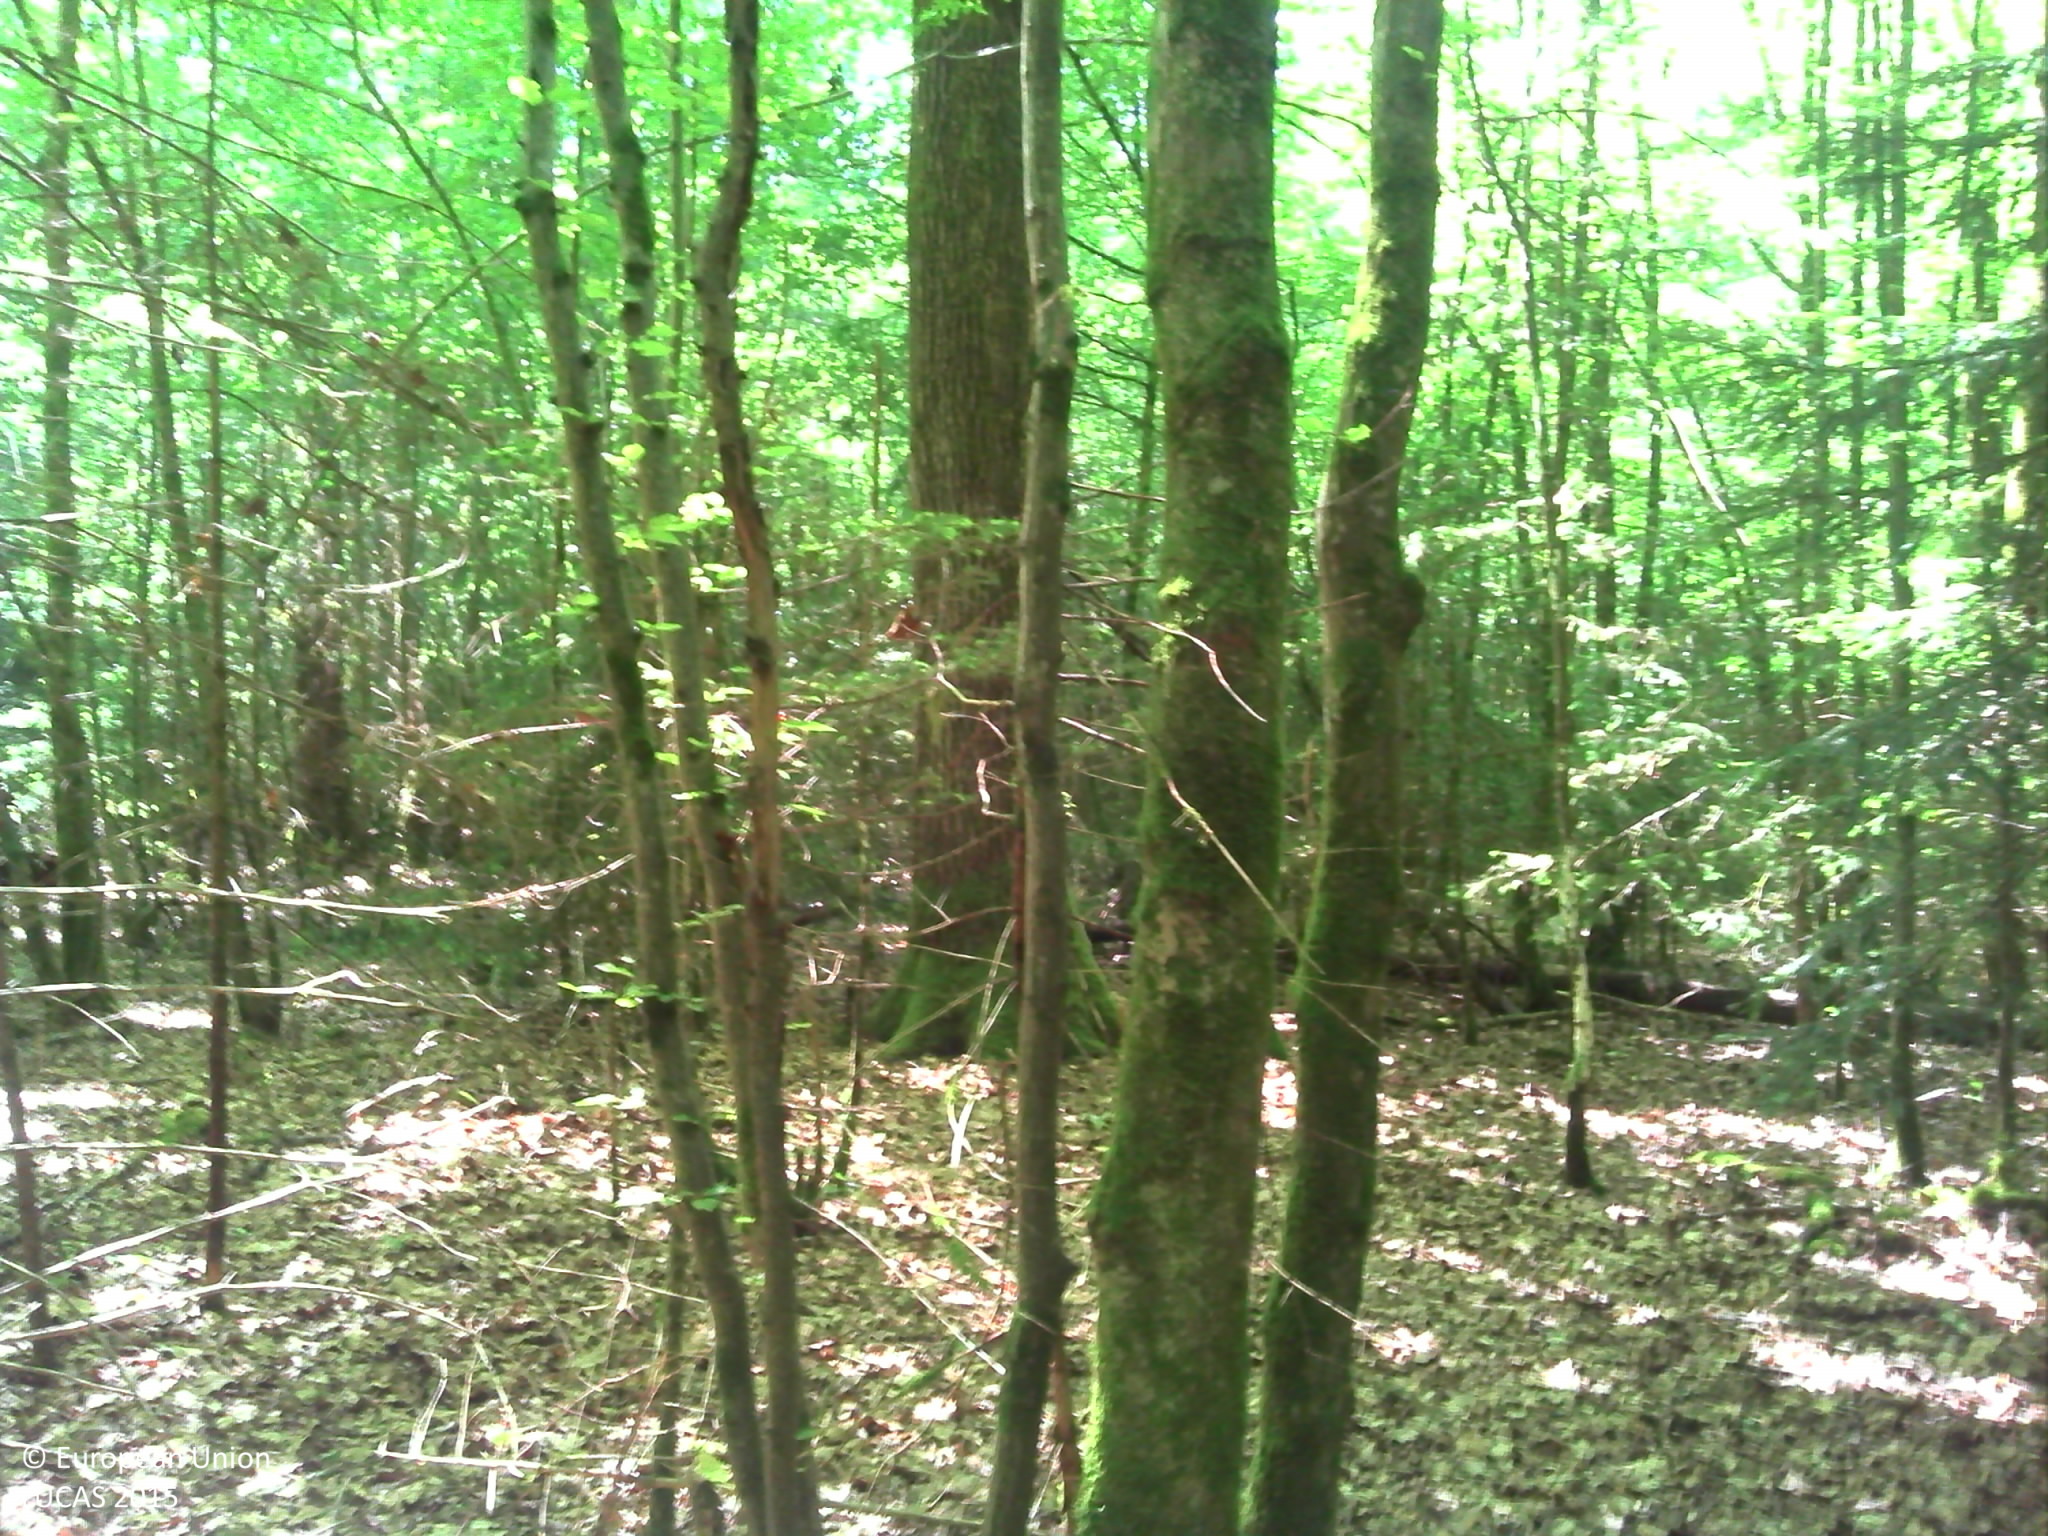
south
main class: Woodland
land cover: Spruce dominated mixed woodland
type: mesophytic deciduous forest
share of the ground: > 75 %
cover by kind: broadleaved forest trees 50 %, coniferous forest trees 45 %, herbaceous plants 5 %
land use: Forestry
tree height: > 5 m
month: June
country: FR
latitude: 48.4673
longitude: 4.9264
